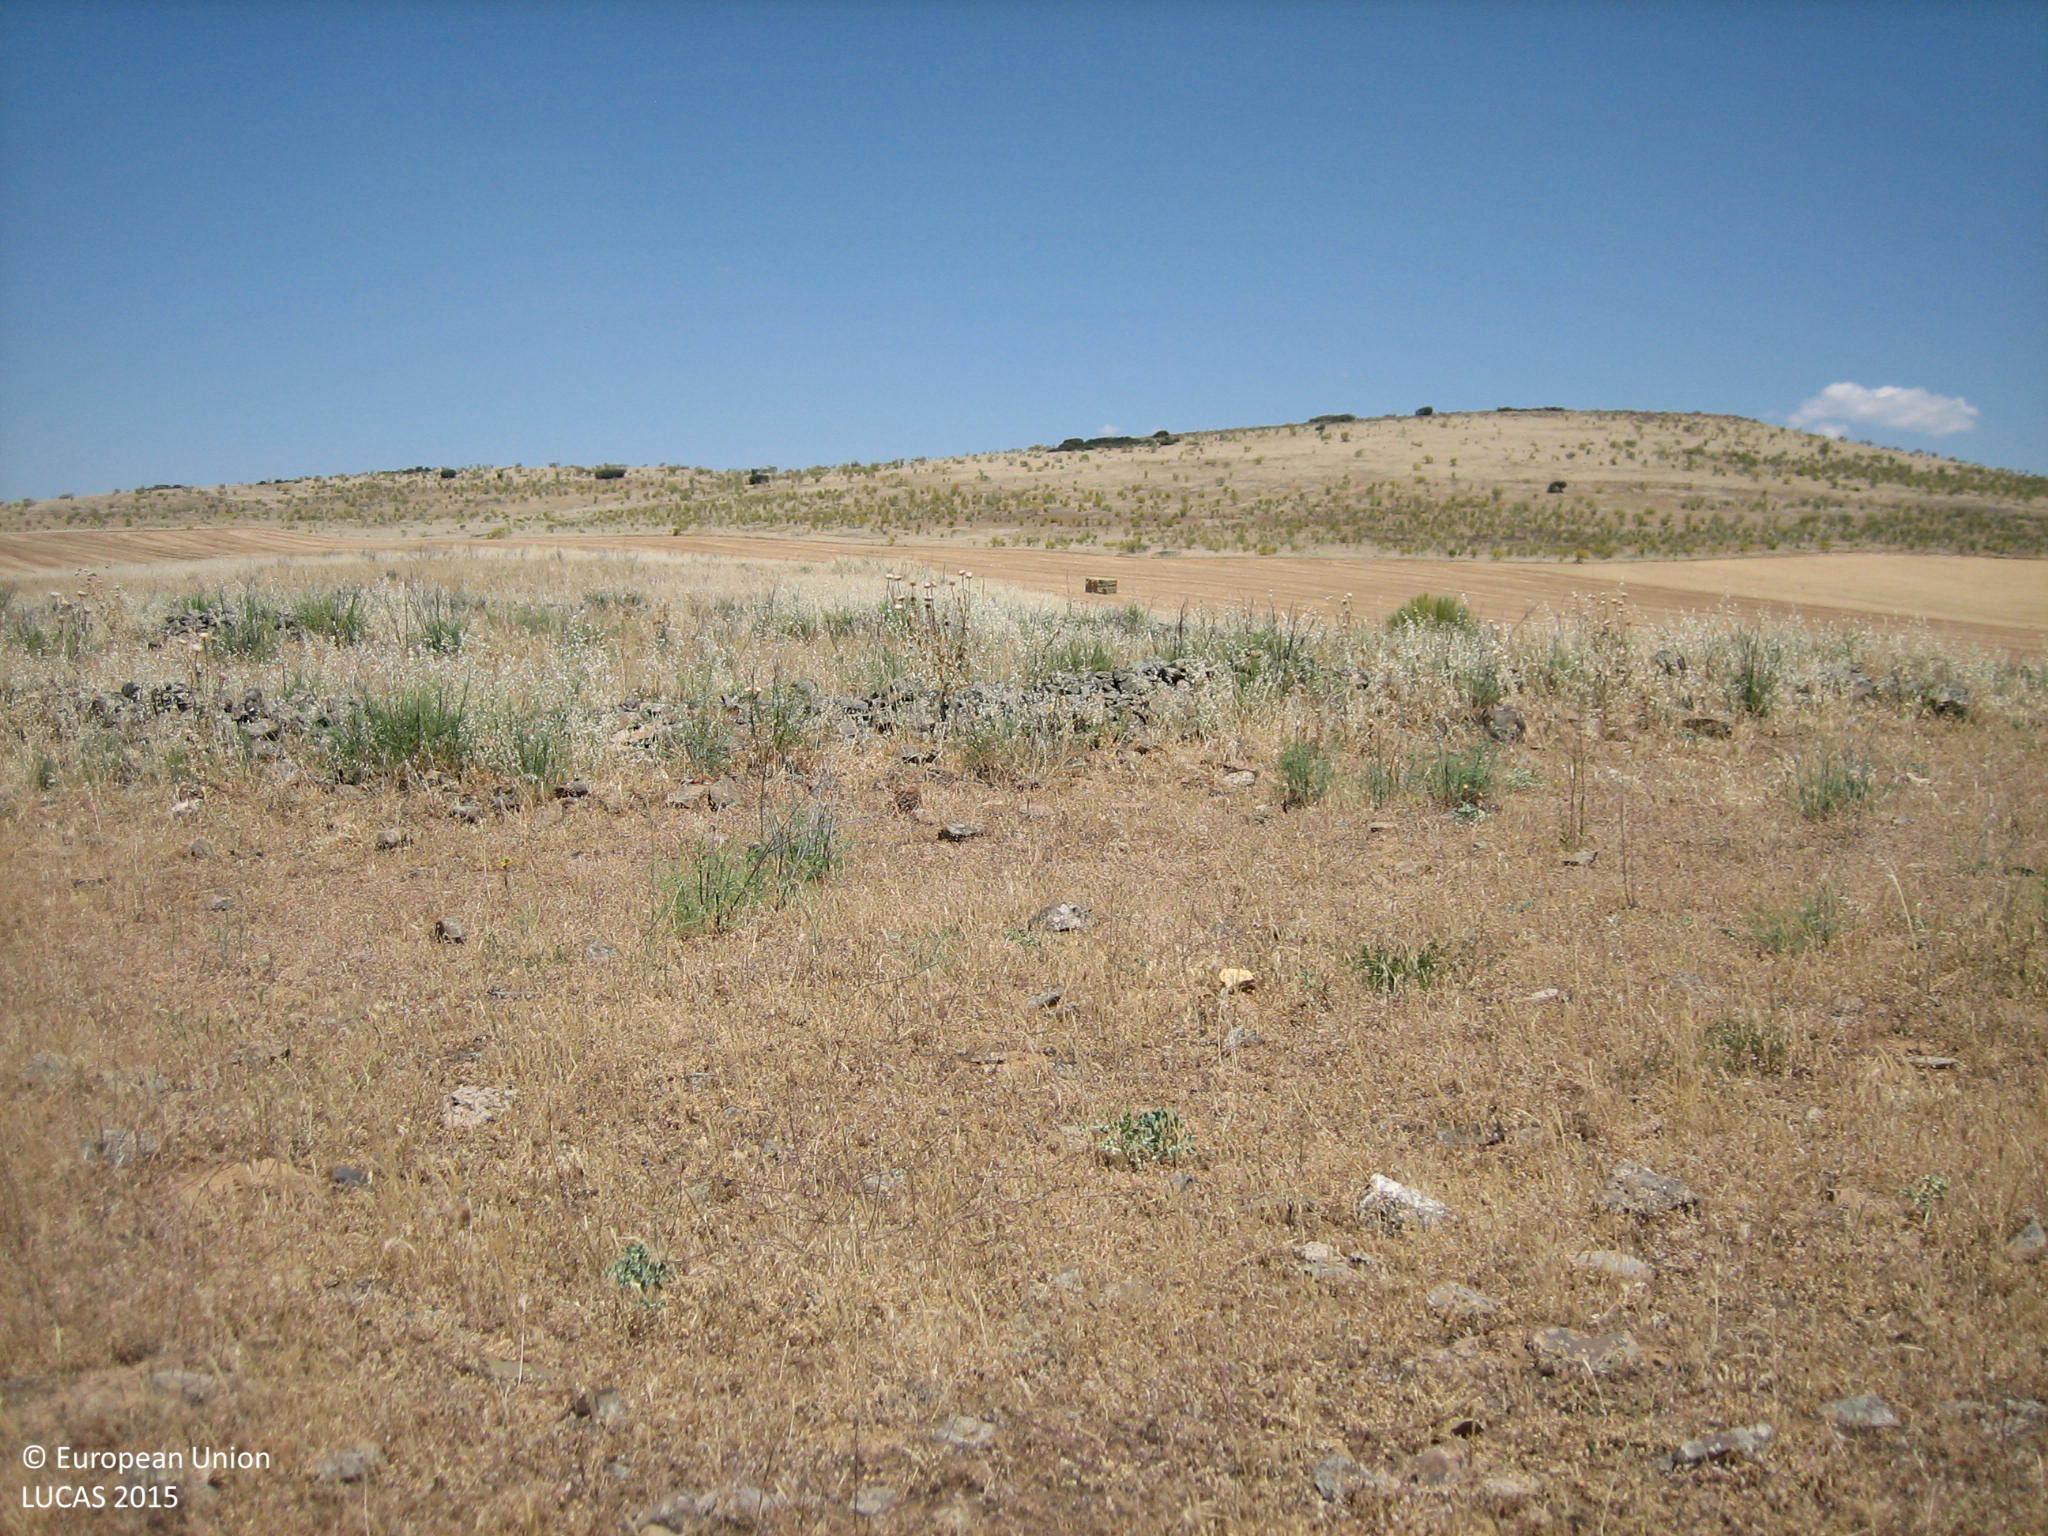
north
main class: Grassland
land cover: Grassland without tree/shrub cover
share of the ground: > 75 %
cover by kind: herbaceous plants 100 %
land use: Agriculture (excluding fallow land and kitchen gardens)
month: May
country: ES
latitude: 38.9017
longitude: -4.0538
